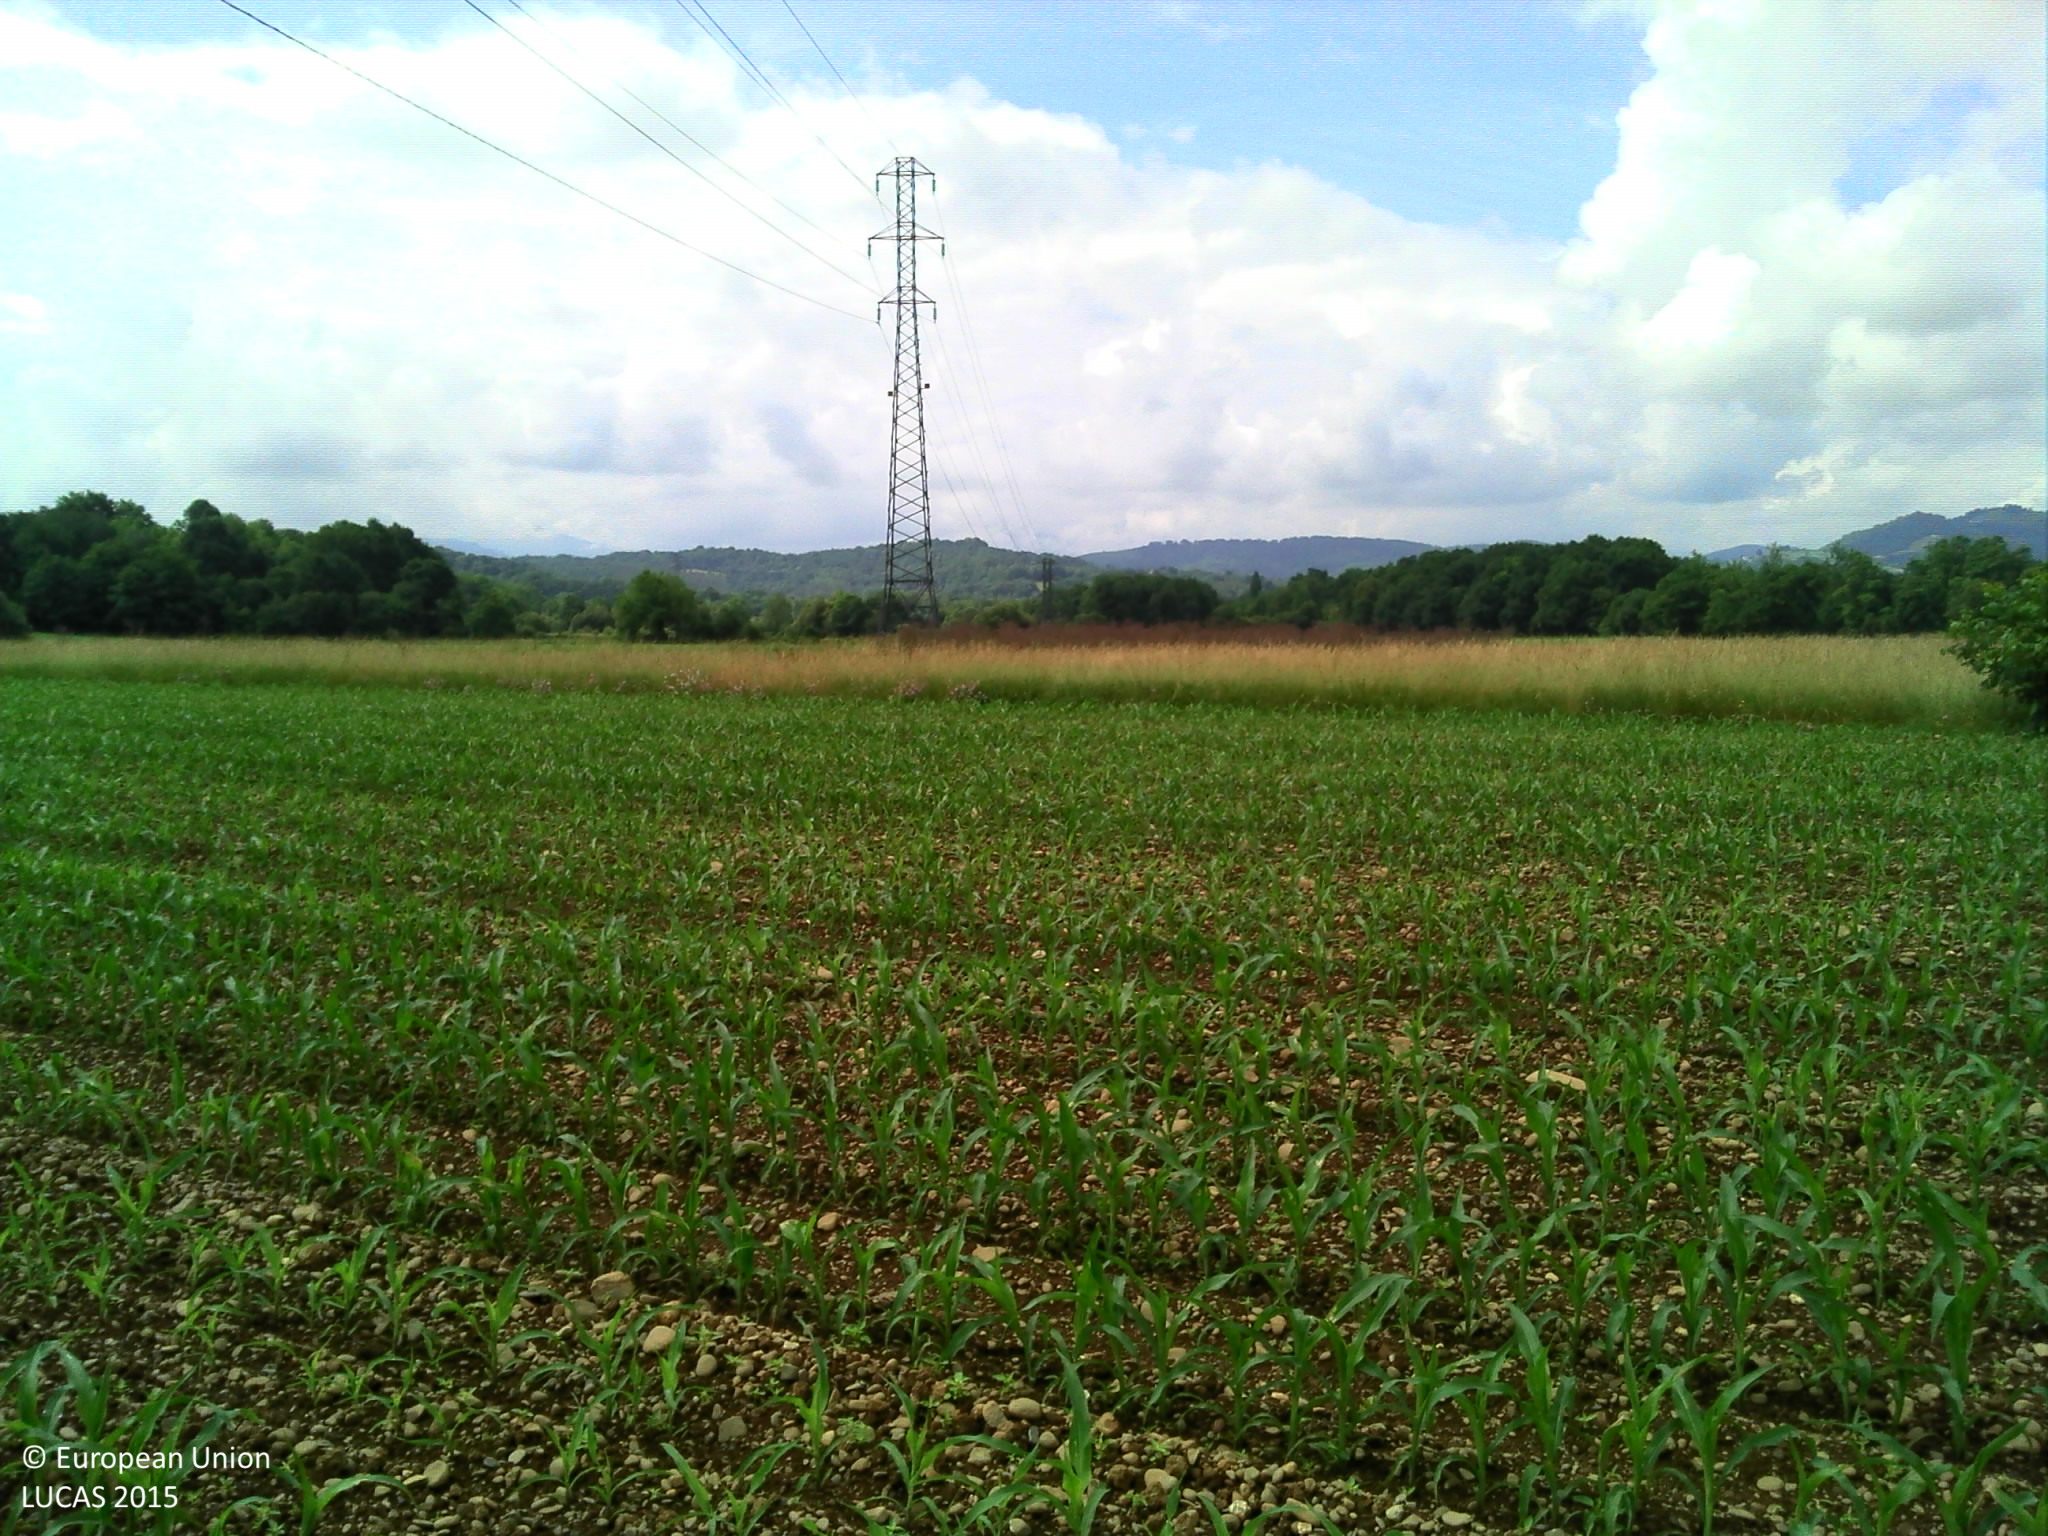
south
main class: Cropland
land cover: Maize
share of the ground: 25 - 50 %
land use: Agriculture (excluding fallow land and kitchen gardens)
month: June
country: FR
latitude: 43.2336
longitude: -0.6847
